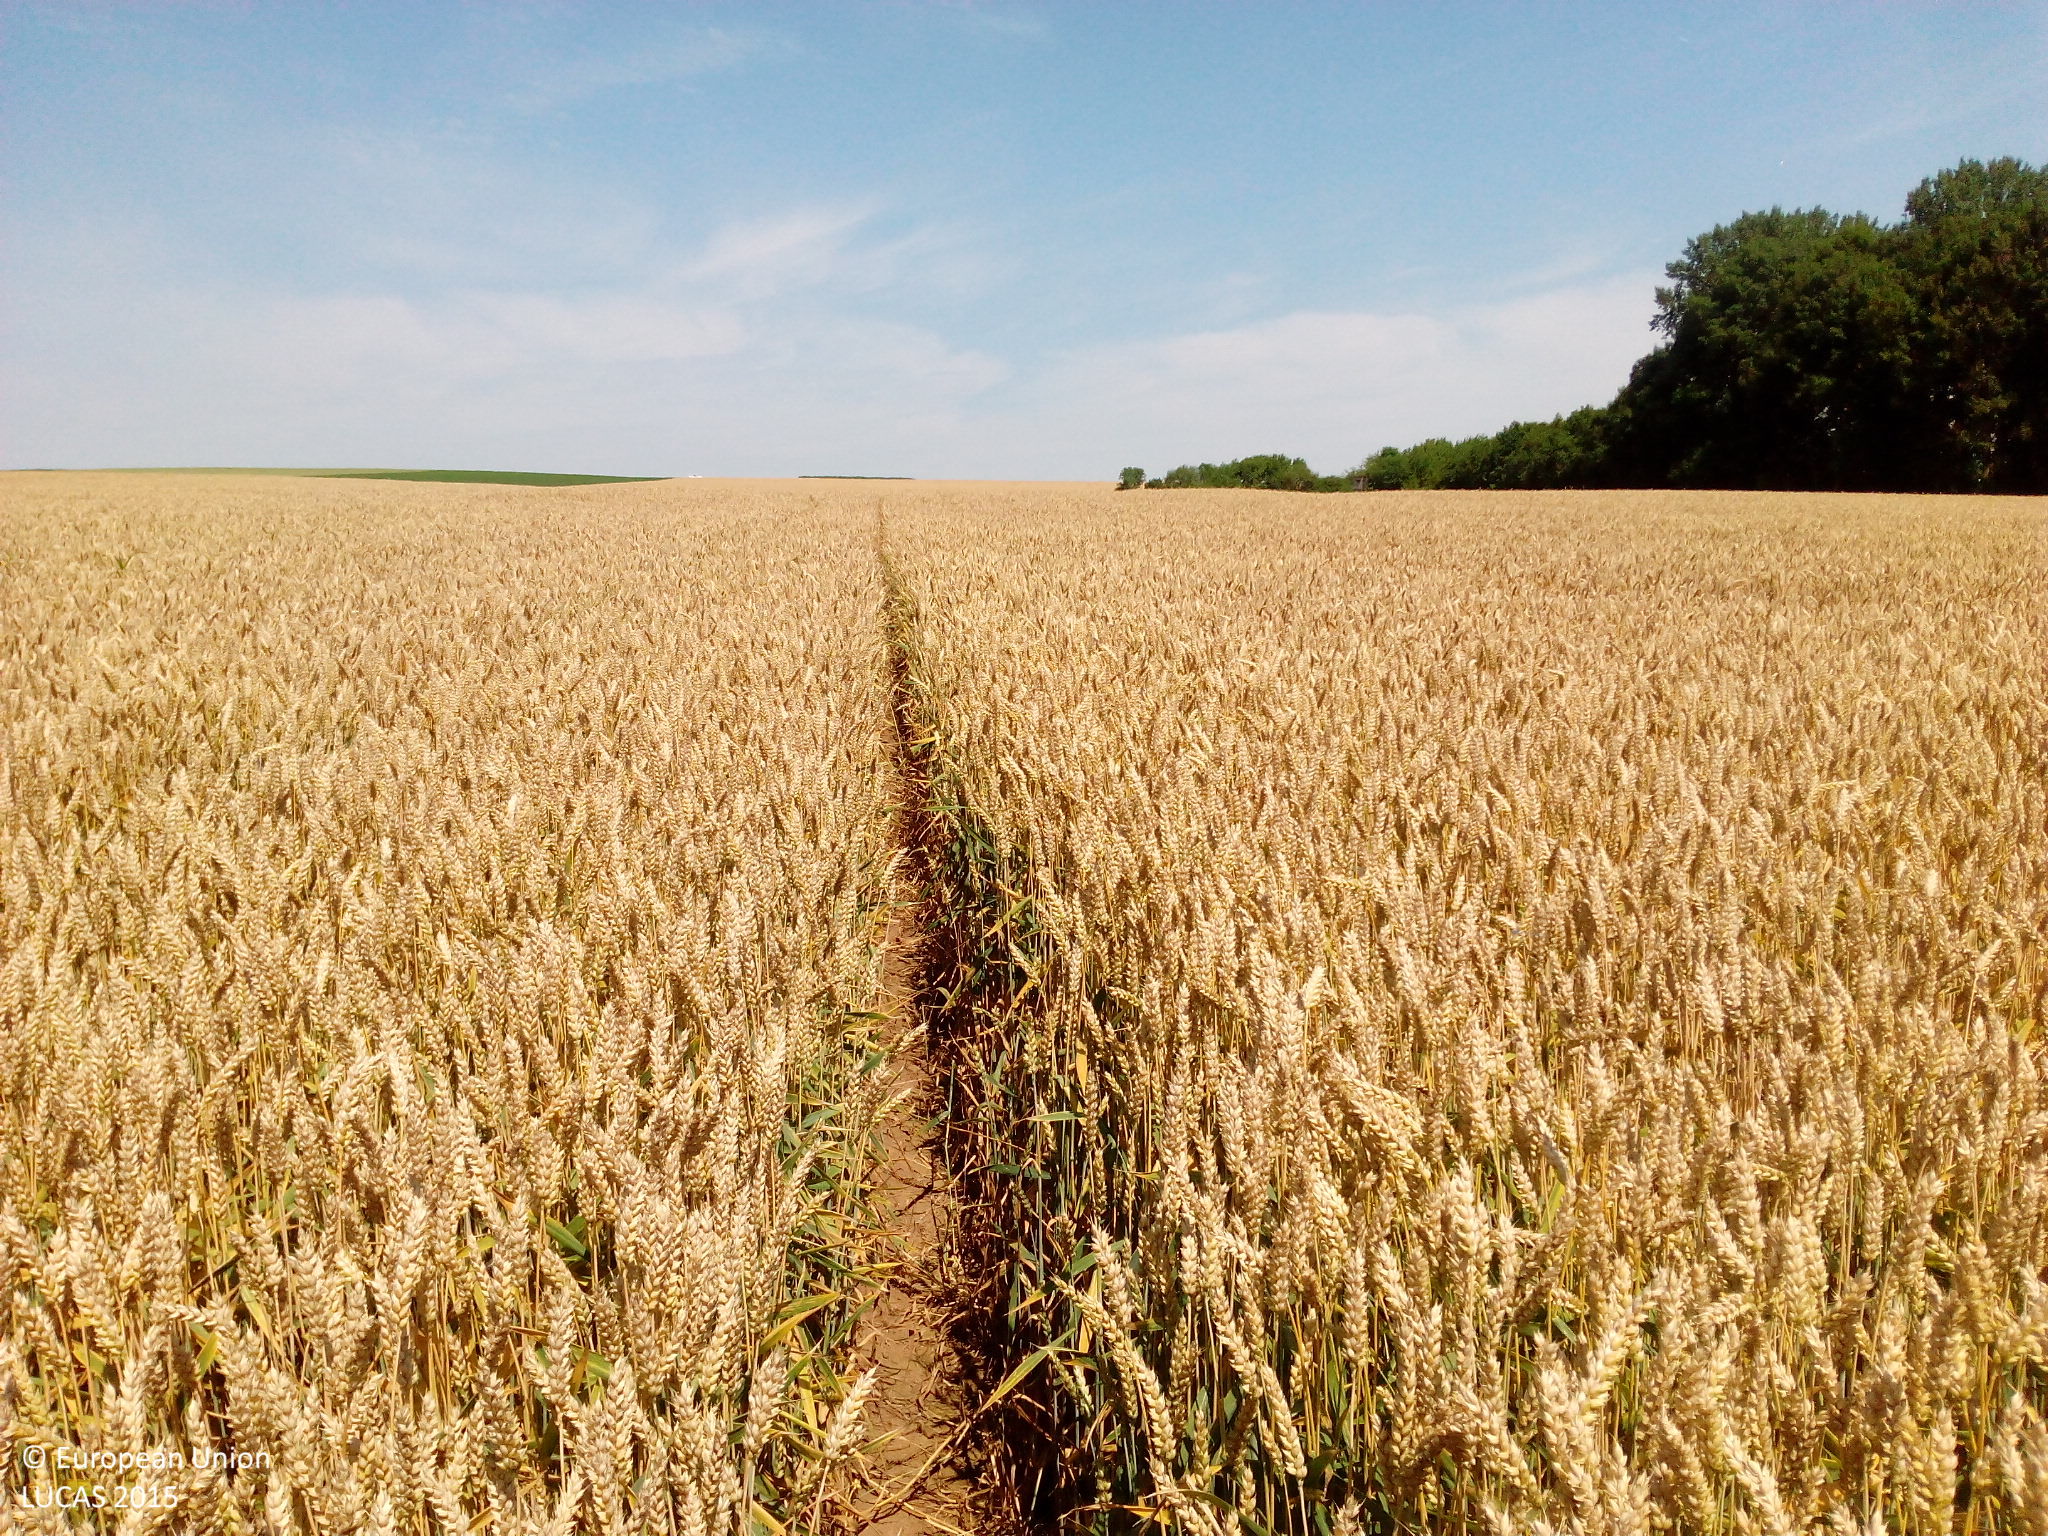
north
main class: Cropland
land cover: Common wheat
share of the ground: > 75 %
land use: Agriculture (excluding fallow land and kitchen gardens)
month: July
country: DE
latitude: 49.6267
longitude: 9.9585
